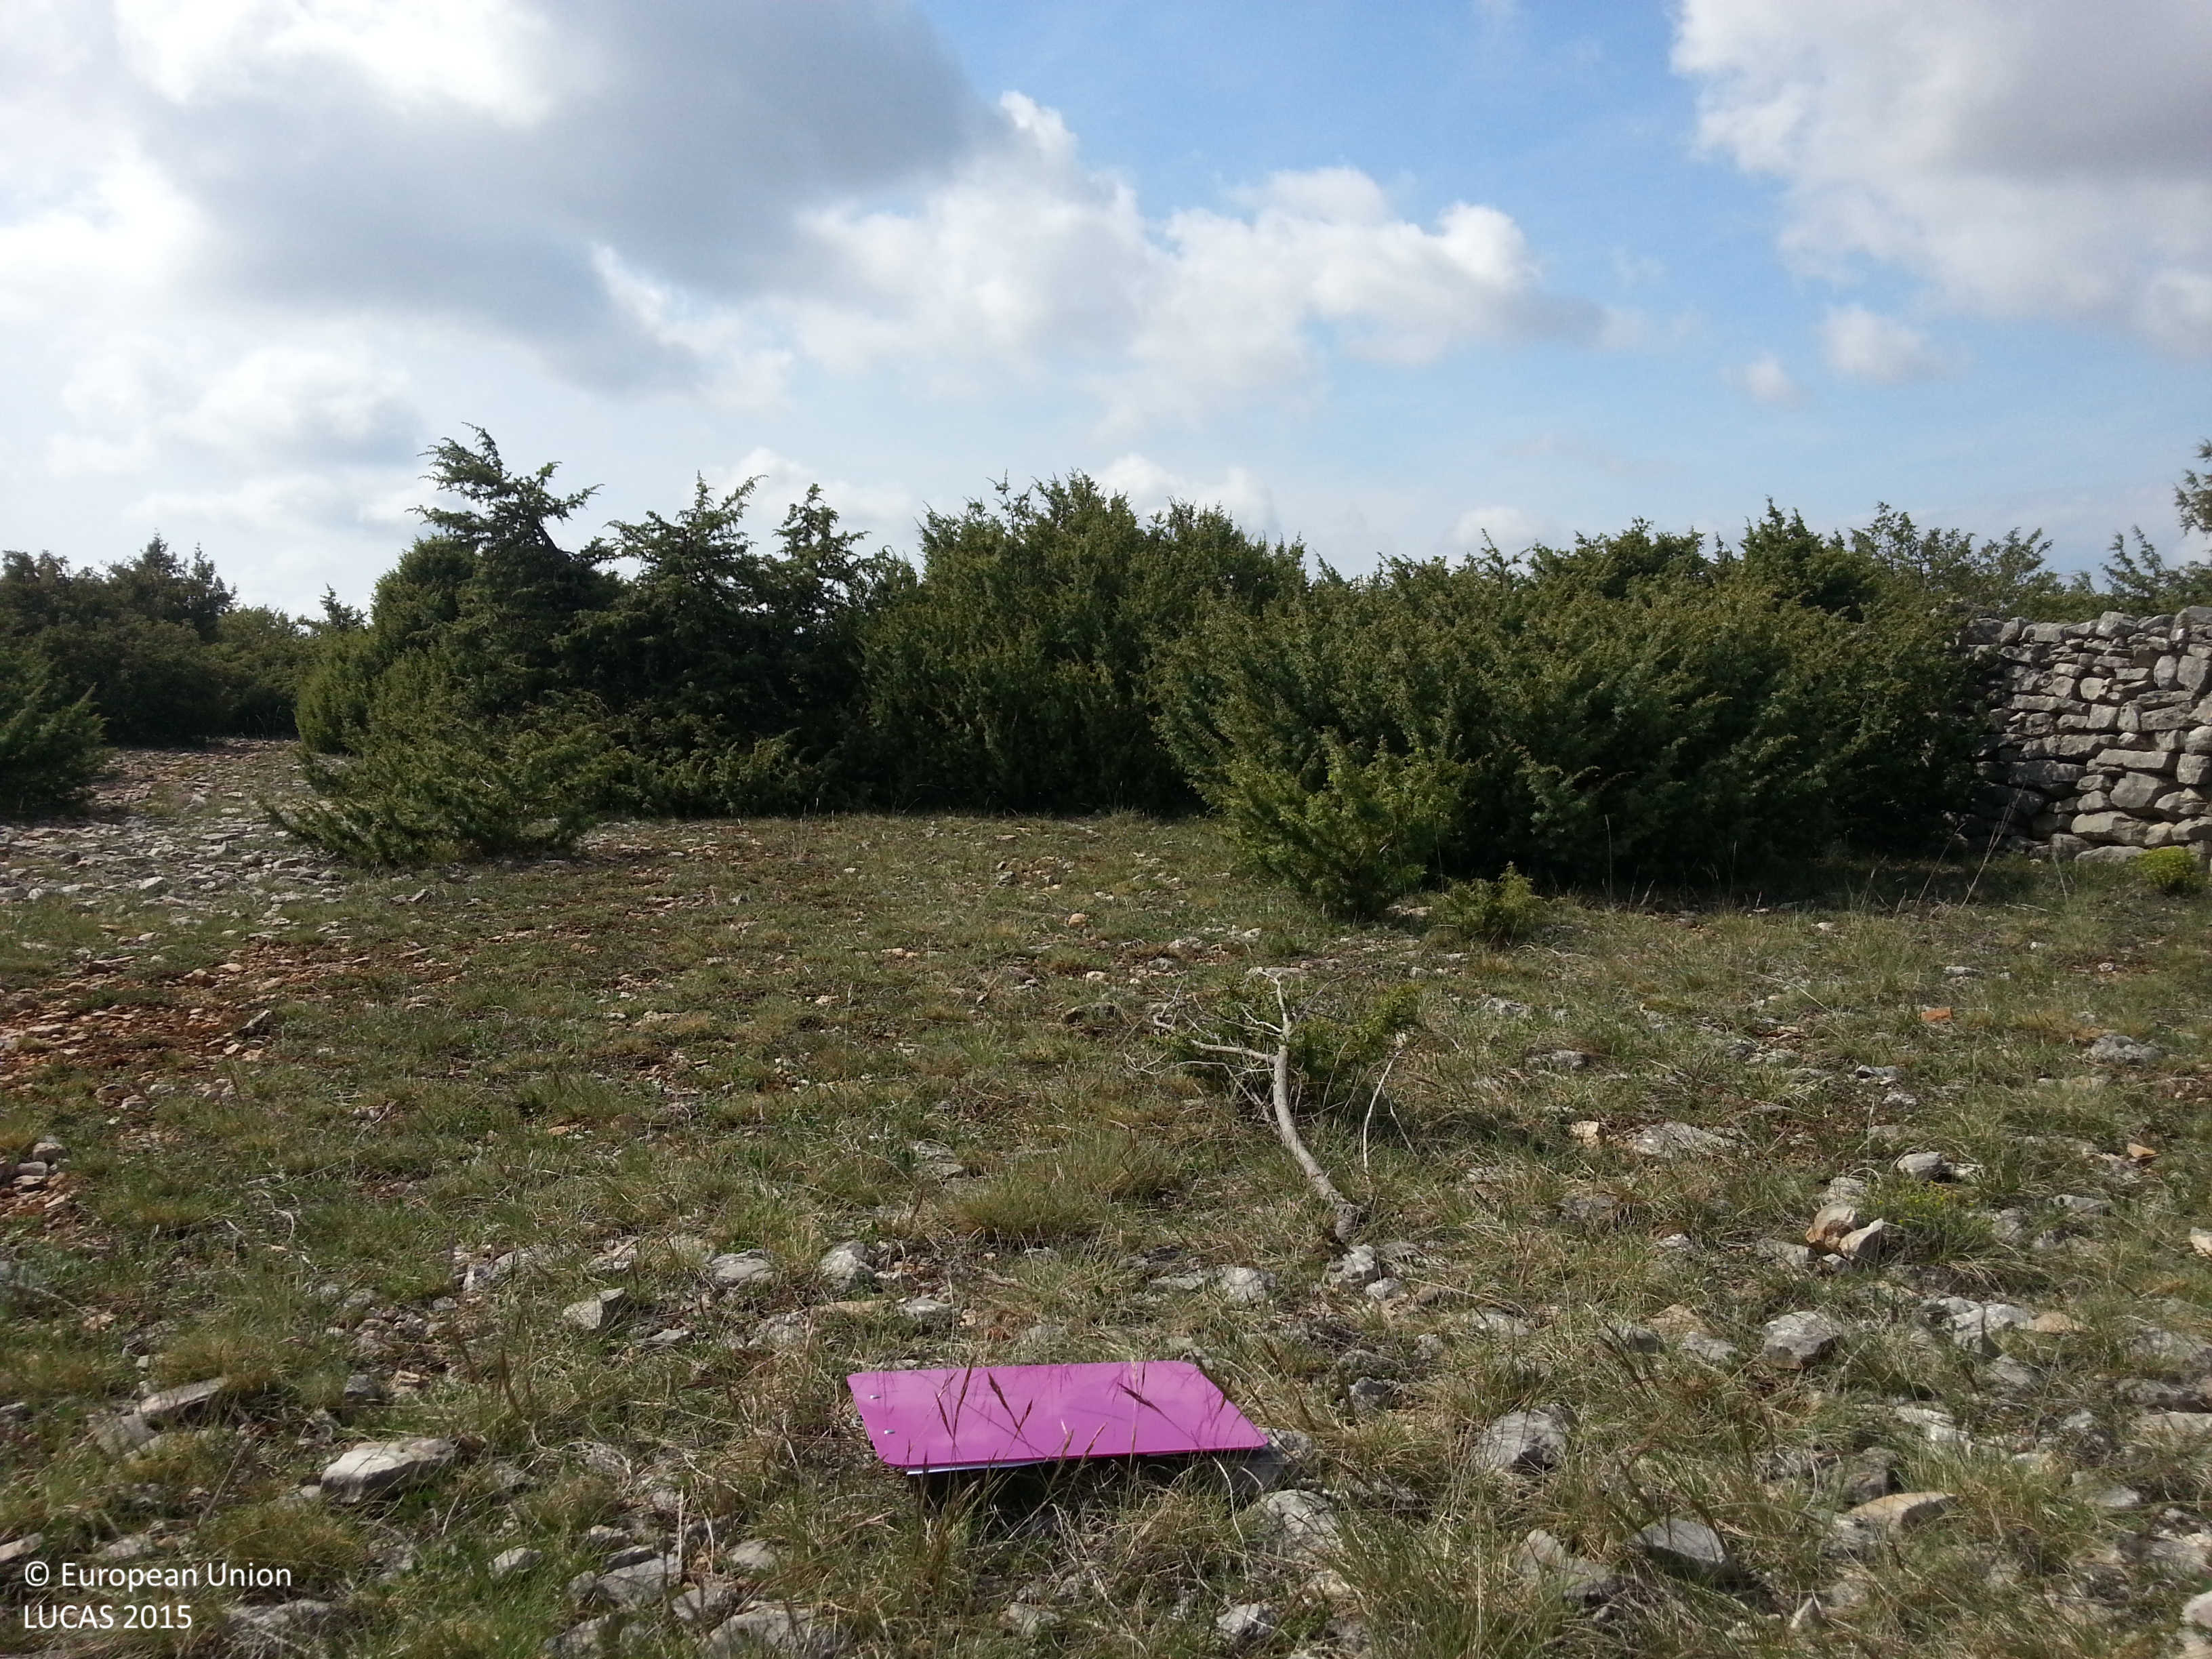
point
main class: Shrubland
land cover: Shrubland without tree cover
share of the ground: 50 - 75 %
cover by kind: shrubs 55 %, herbaceous plants 25 %, unconsolidated bare surface 20 %
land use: Abandoned areas
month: April
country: HR
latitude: 44.0342
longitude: 15.6445
